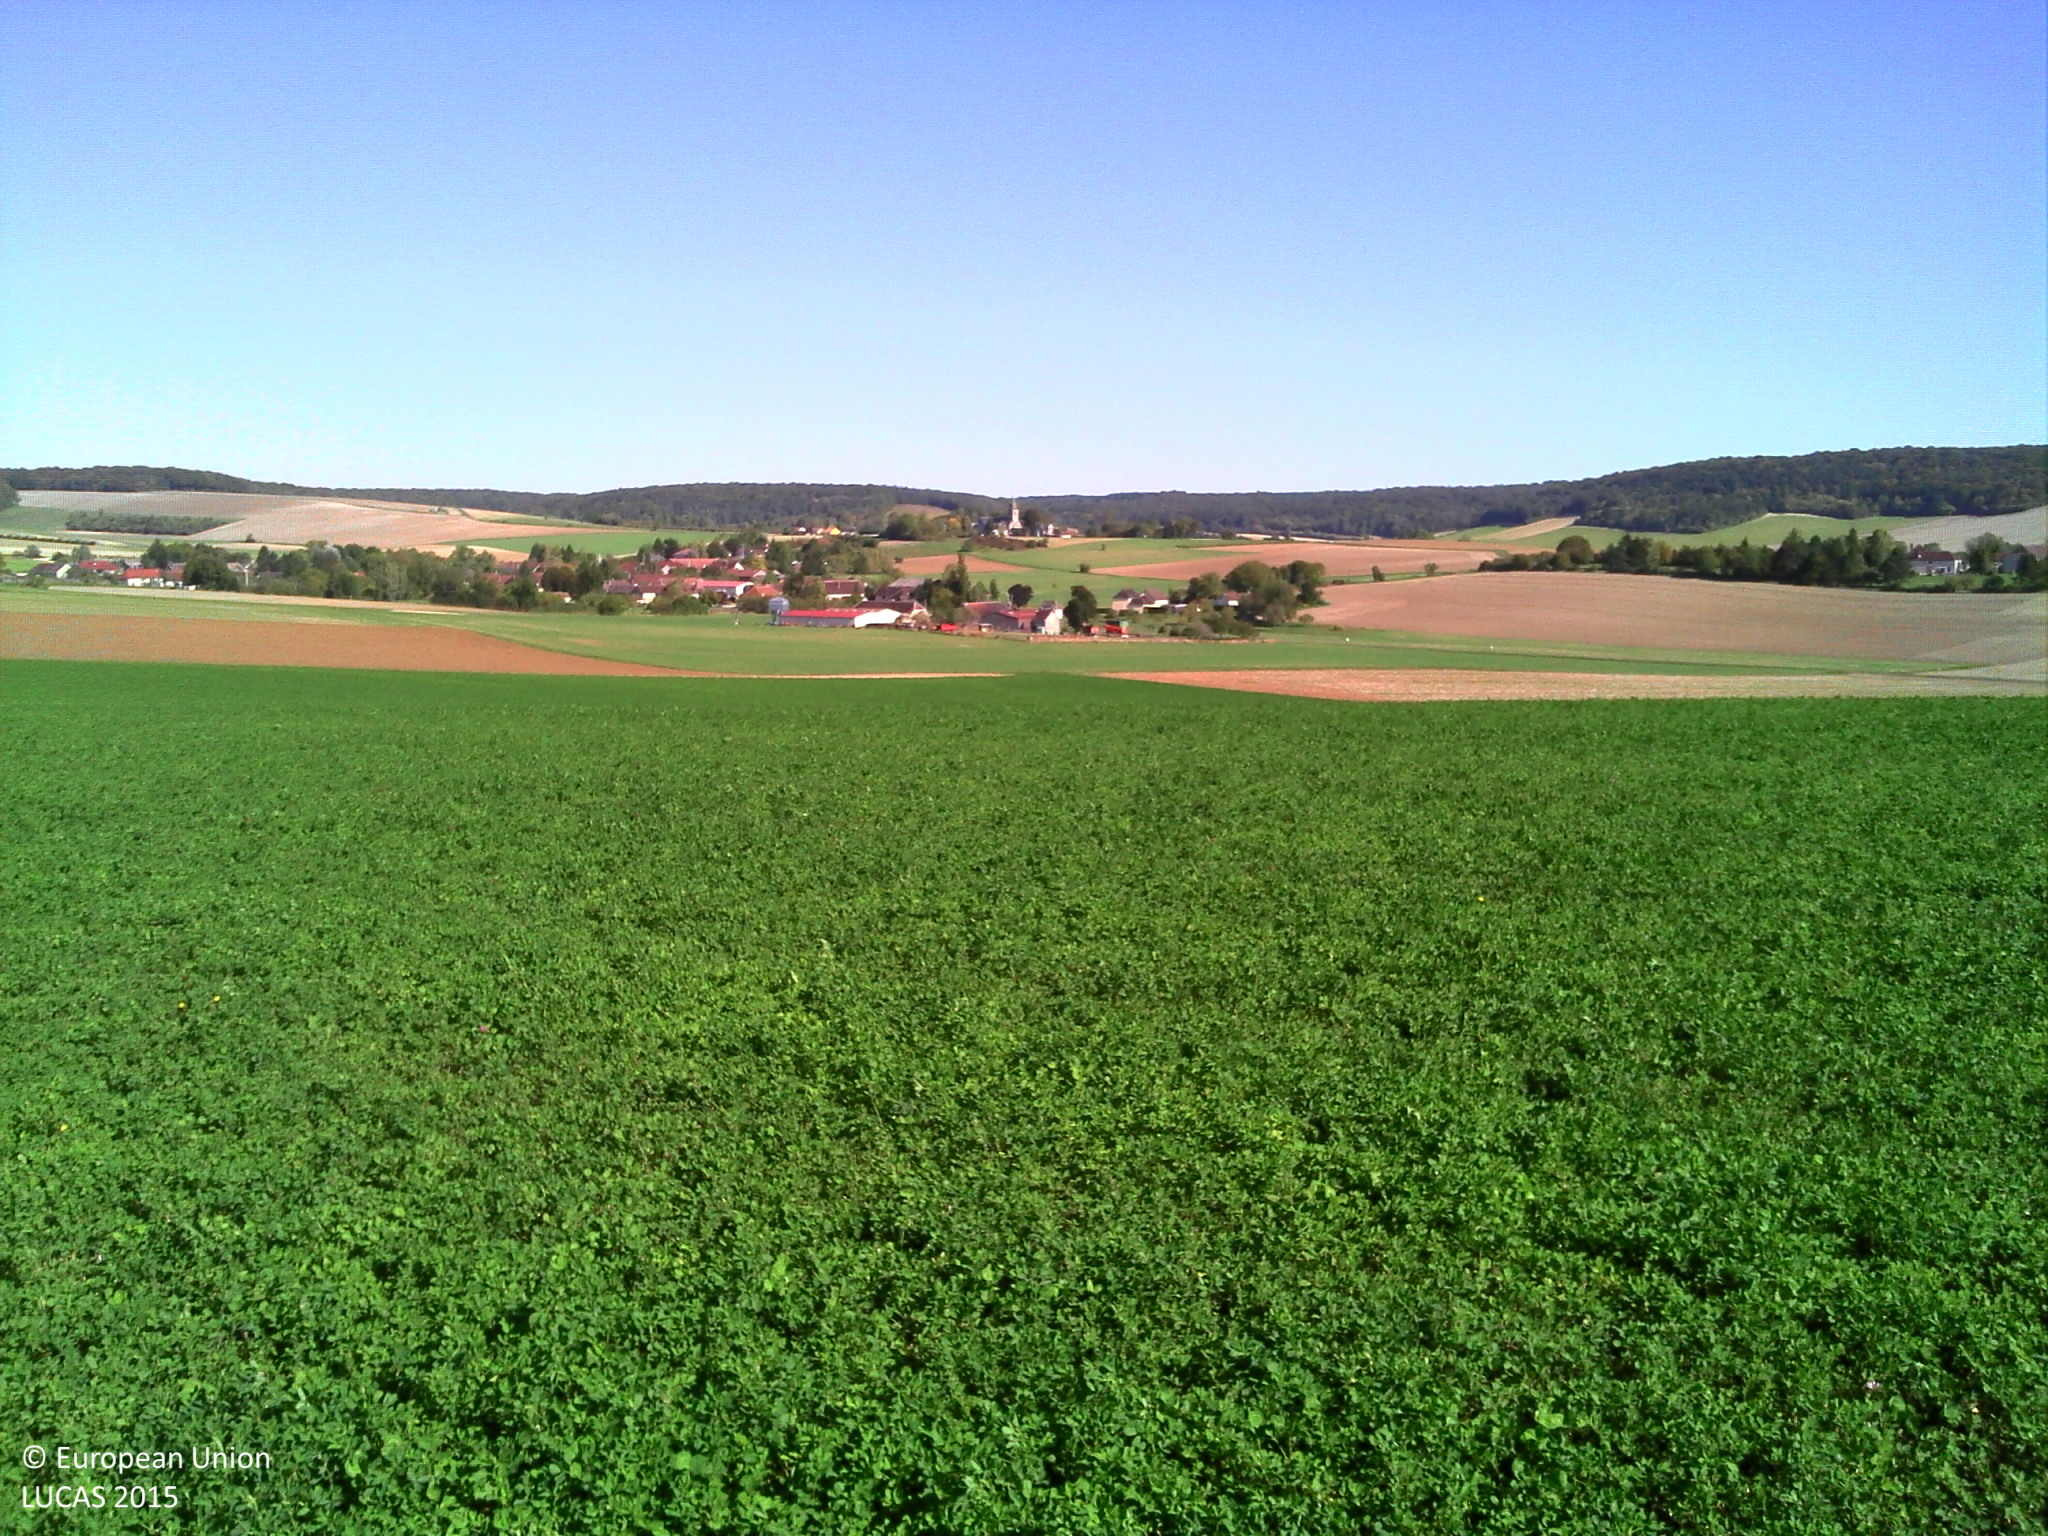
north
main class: Cropland
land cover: Lucerne
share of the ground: > 75 %
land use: Agriculture (excluding fallow land and kitchen gardens)
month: September
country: FR
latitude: 48.1079
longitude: 3.8852
